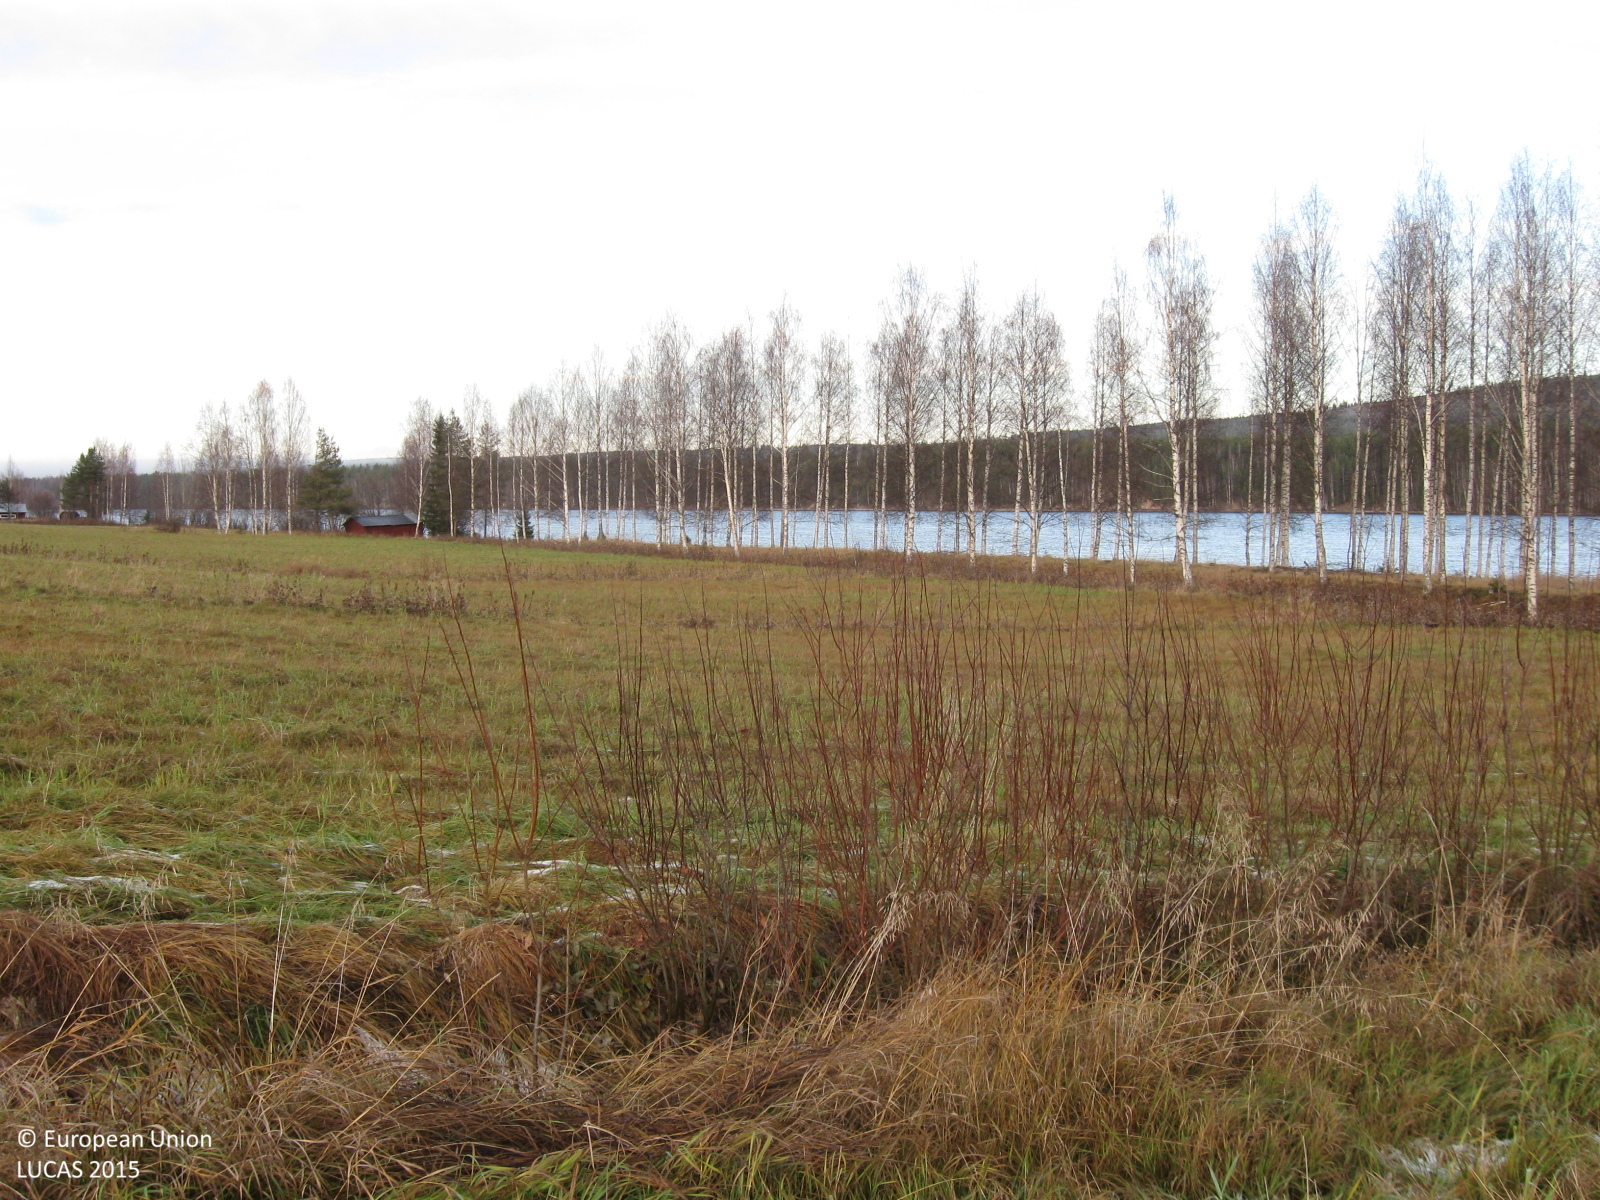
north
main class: Grassland
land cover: Grassland without tree/shrub cover
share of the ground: > 75 %
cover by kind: herbaceous plants 100 %
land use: Agriculture (excluding fallow land and kitchen gardens)
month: October
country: SE
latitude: 66.2944
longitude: 20.8157
